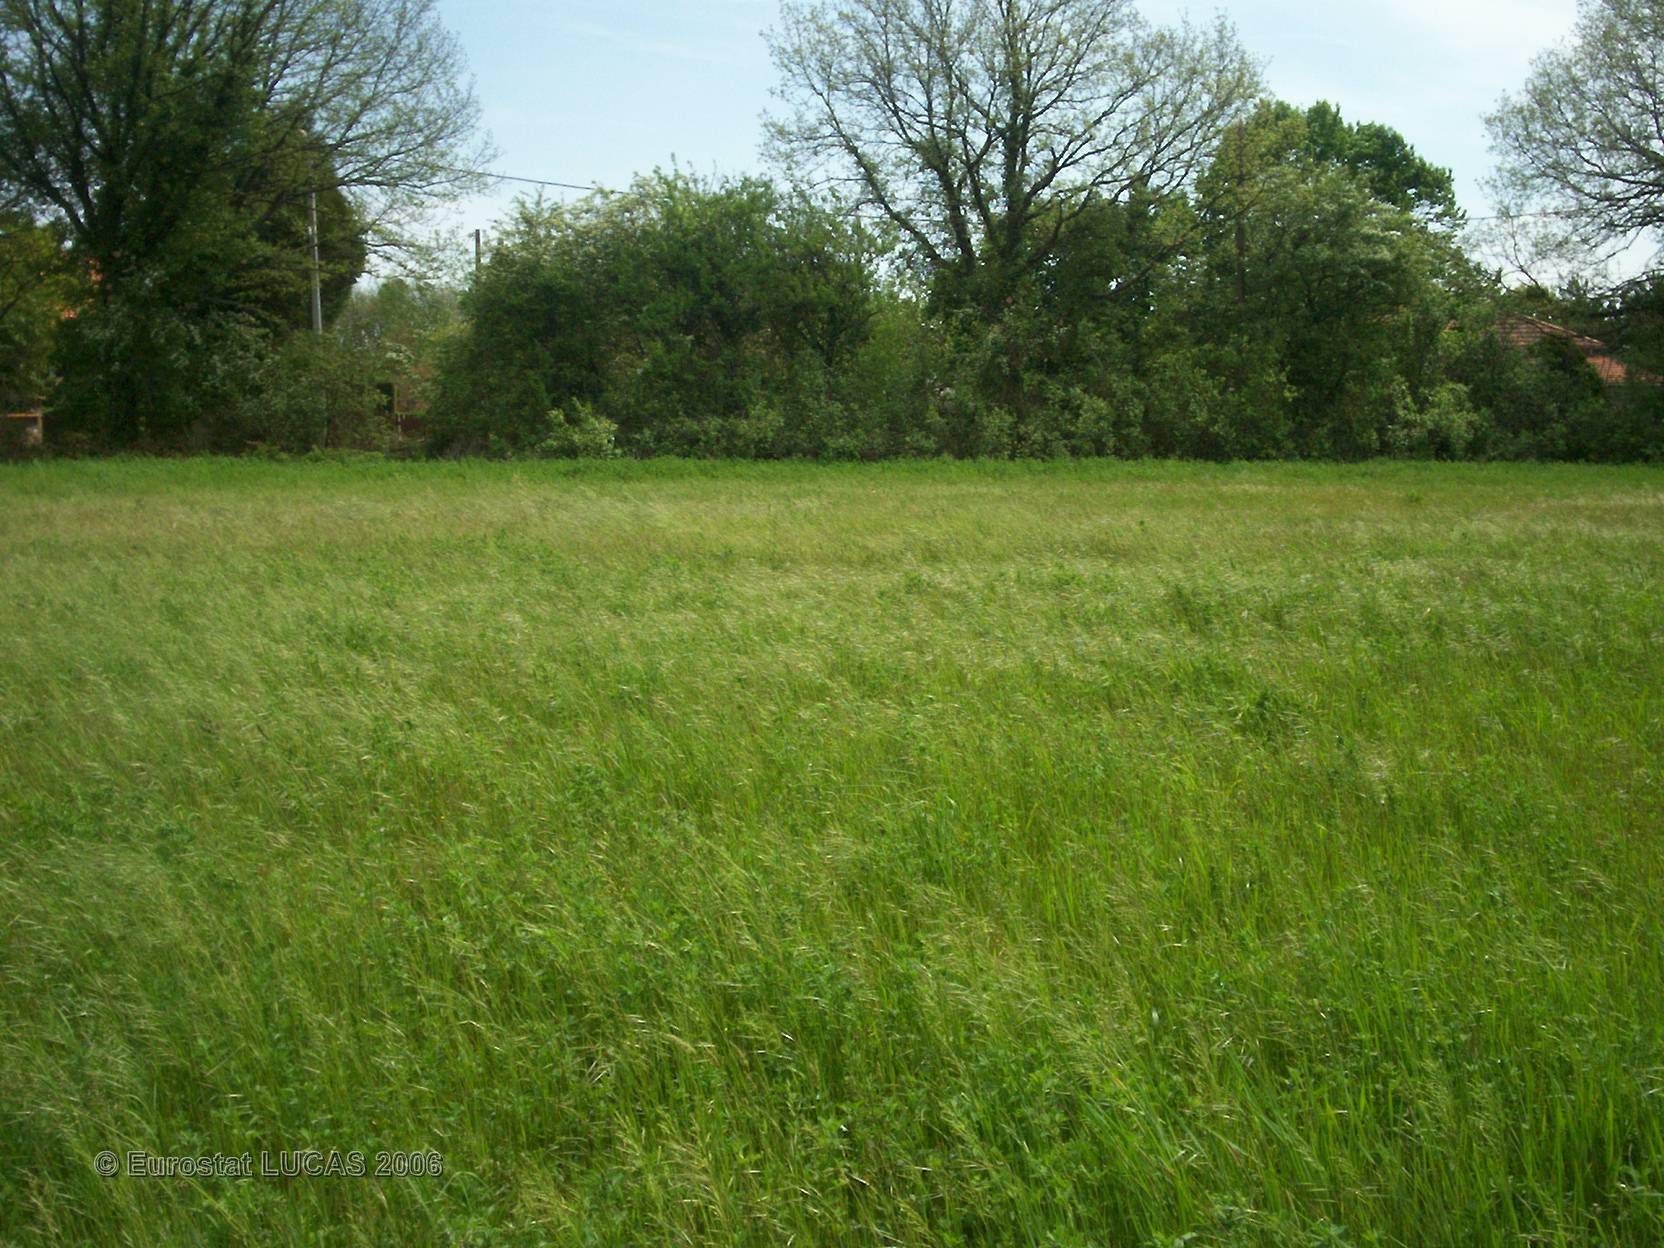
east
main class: Grassland
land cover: Grassland without tree/shrub cover
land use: Agriculture (excluding fallow land and kitchen gardens)
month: May
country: FR
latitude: 46.5596
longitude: 0.4727
